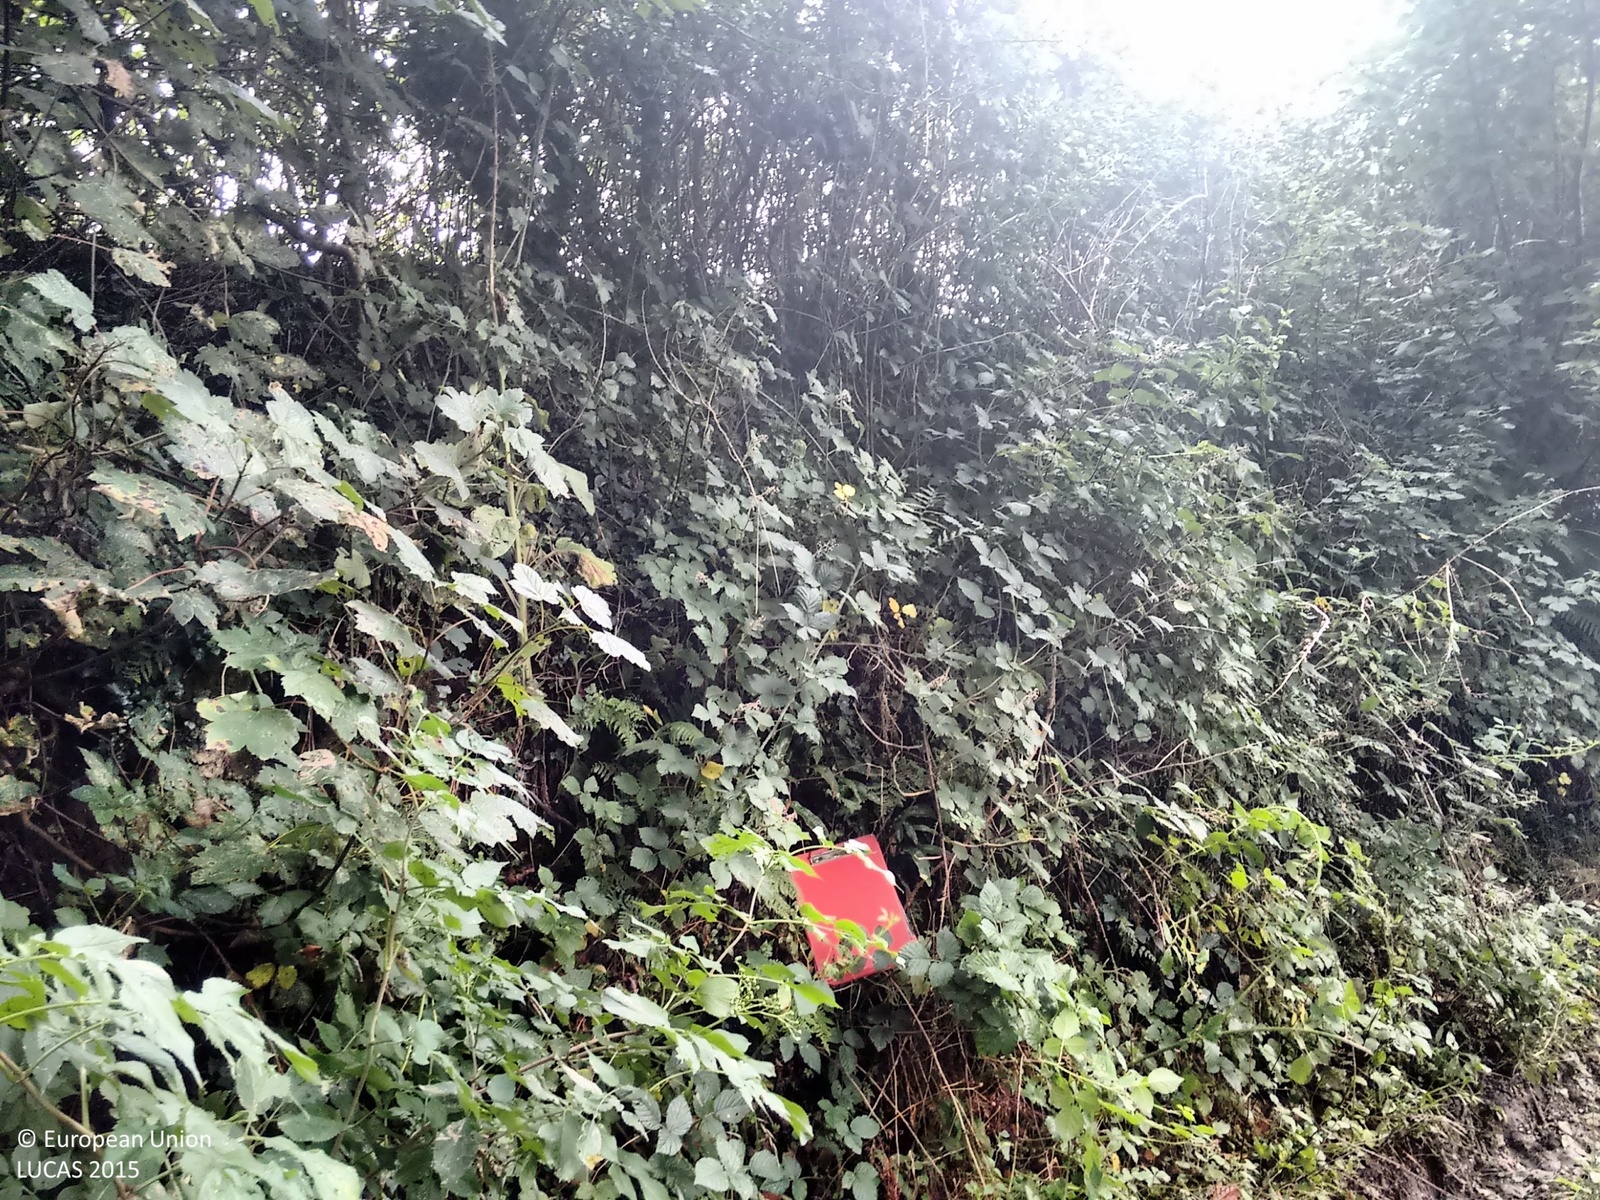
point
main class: Woodland
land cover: Broadleaved woodland
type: mesophytic deciduous forest
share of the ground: > 75 %
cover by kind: broadleaved forest trees 100 %
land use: Semi-natural and natural areas not in use
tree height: > 5 m
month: September
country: GB
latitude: 50.7507
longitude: -4.4908
